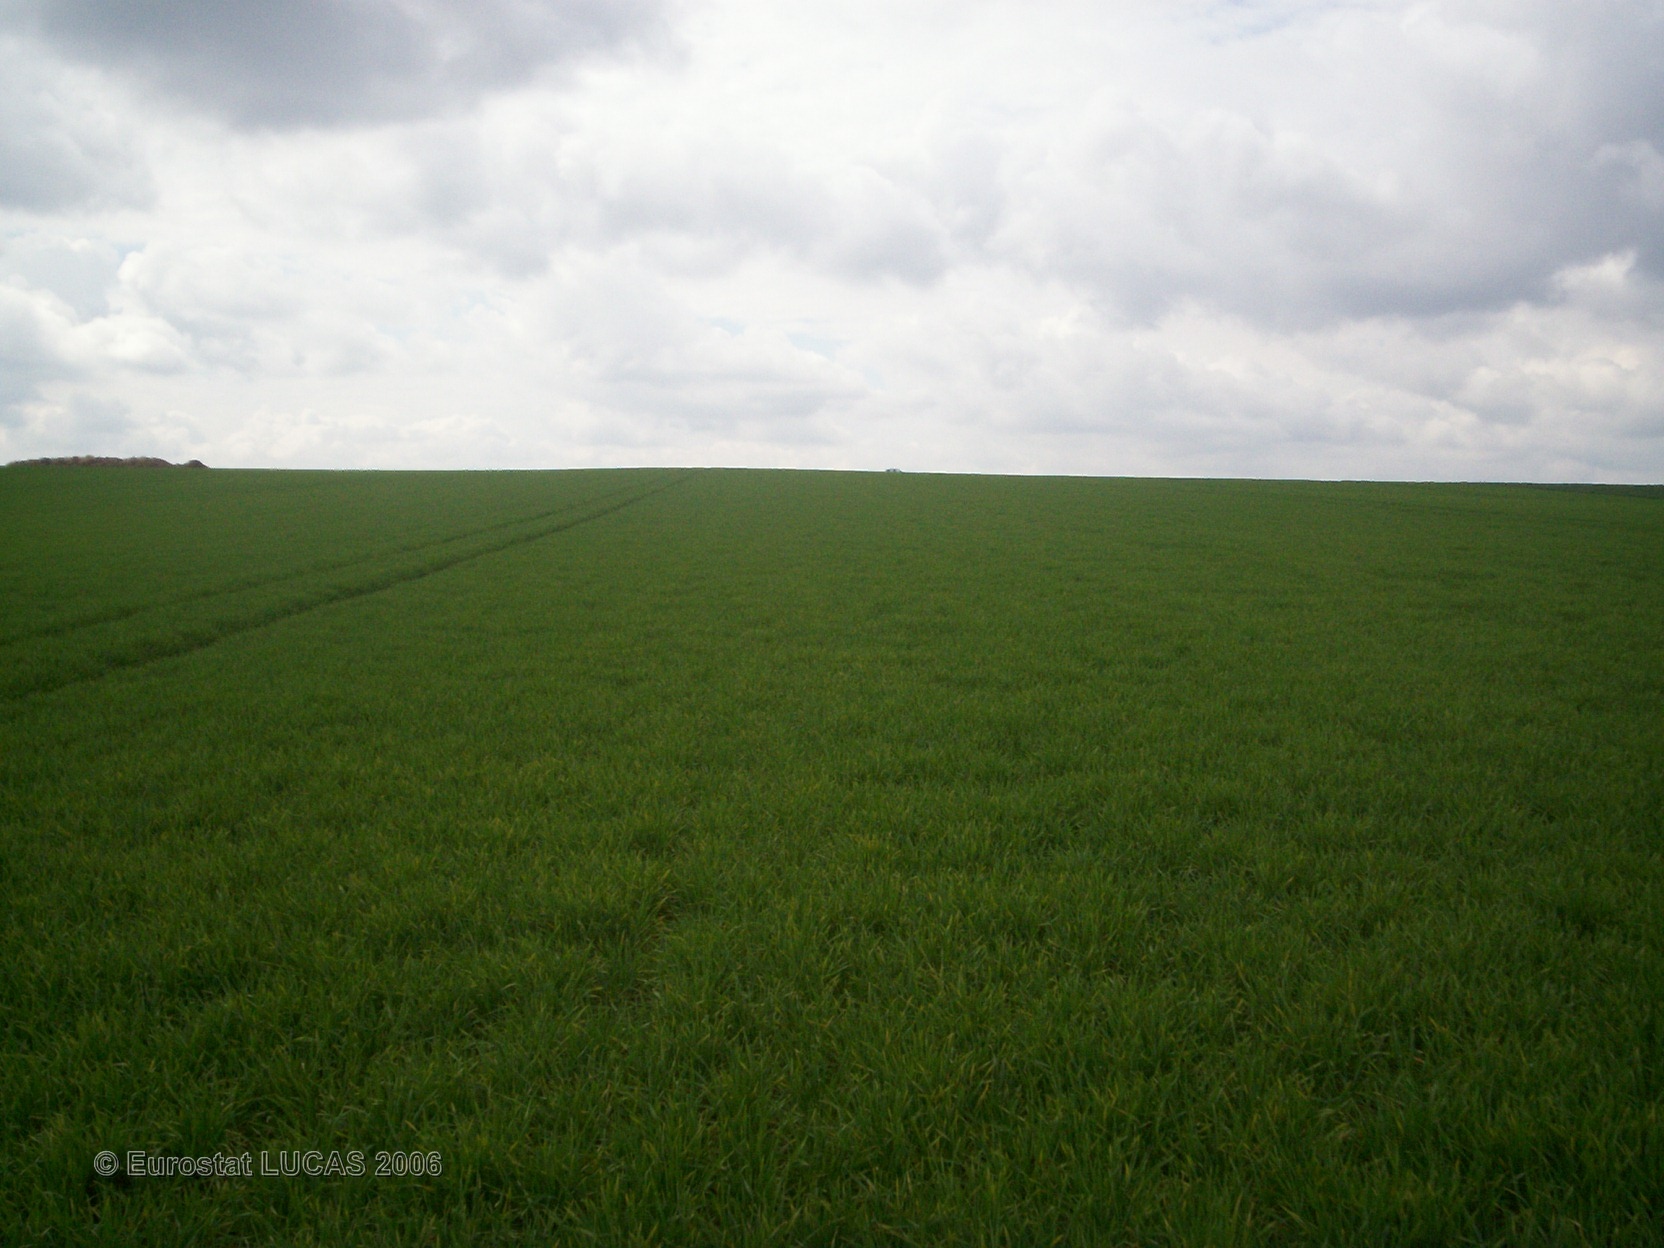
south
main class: Cropland
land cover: Barley
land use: Agriculture (excluding fallow land and kitchen gardens)
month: April
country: FR
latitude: 48.9460
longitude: 5.1511
